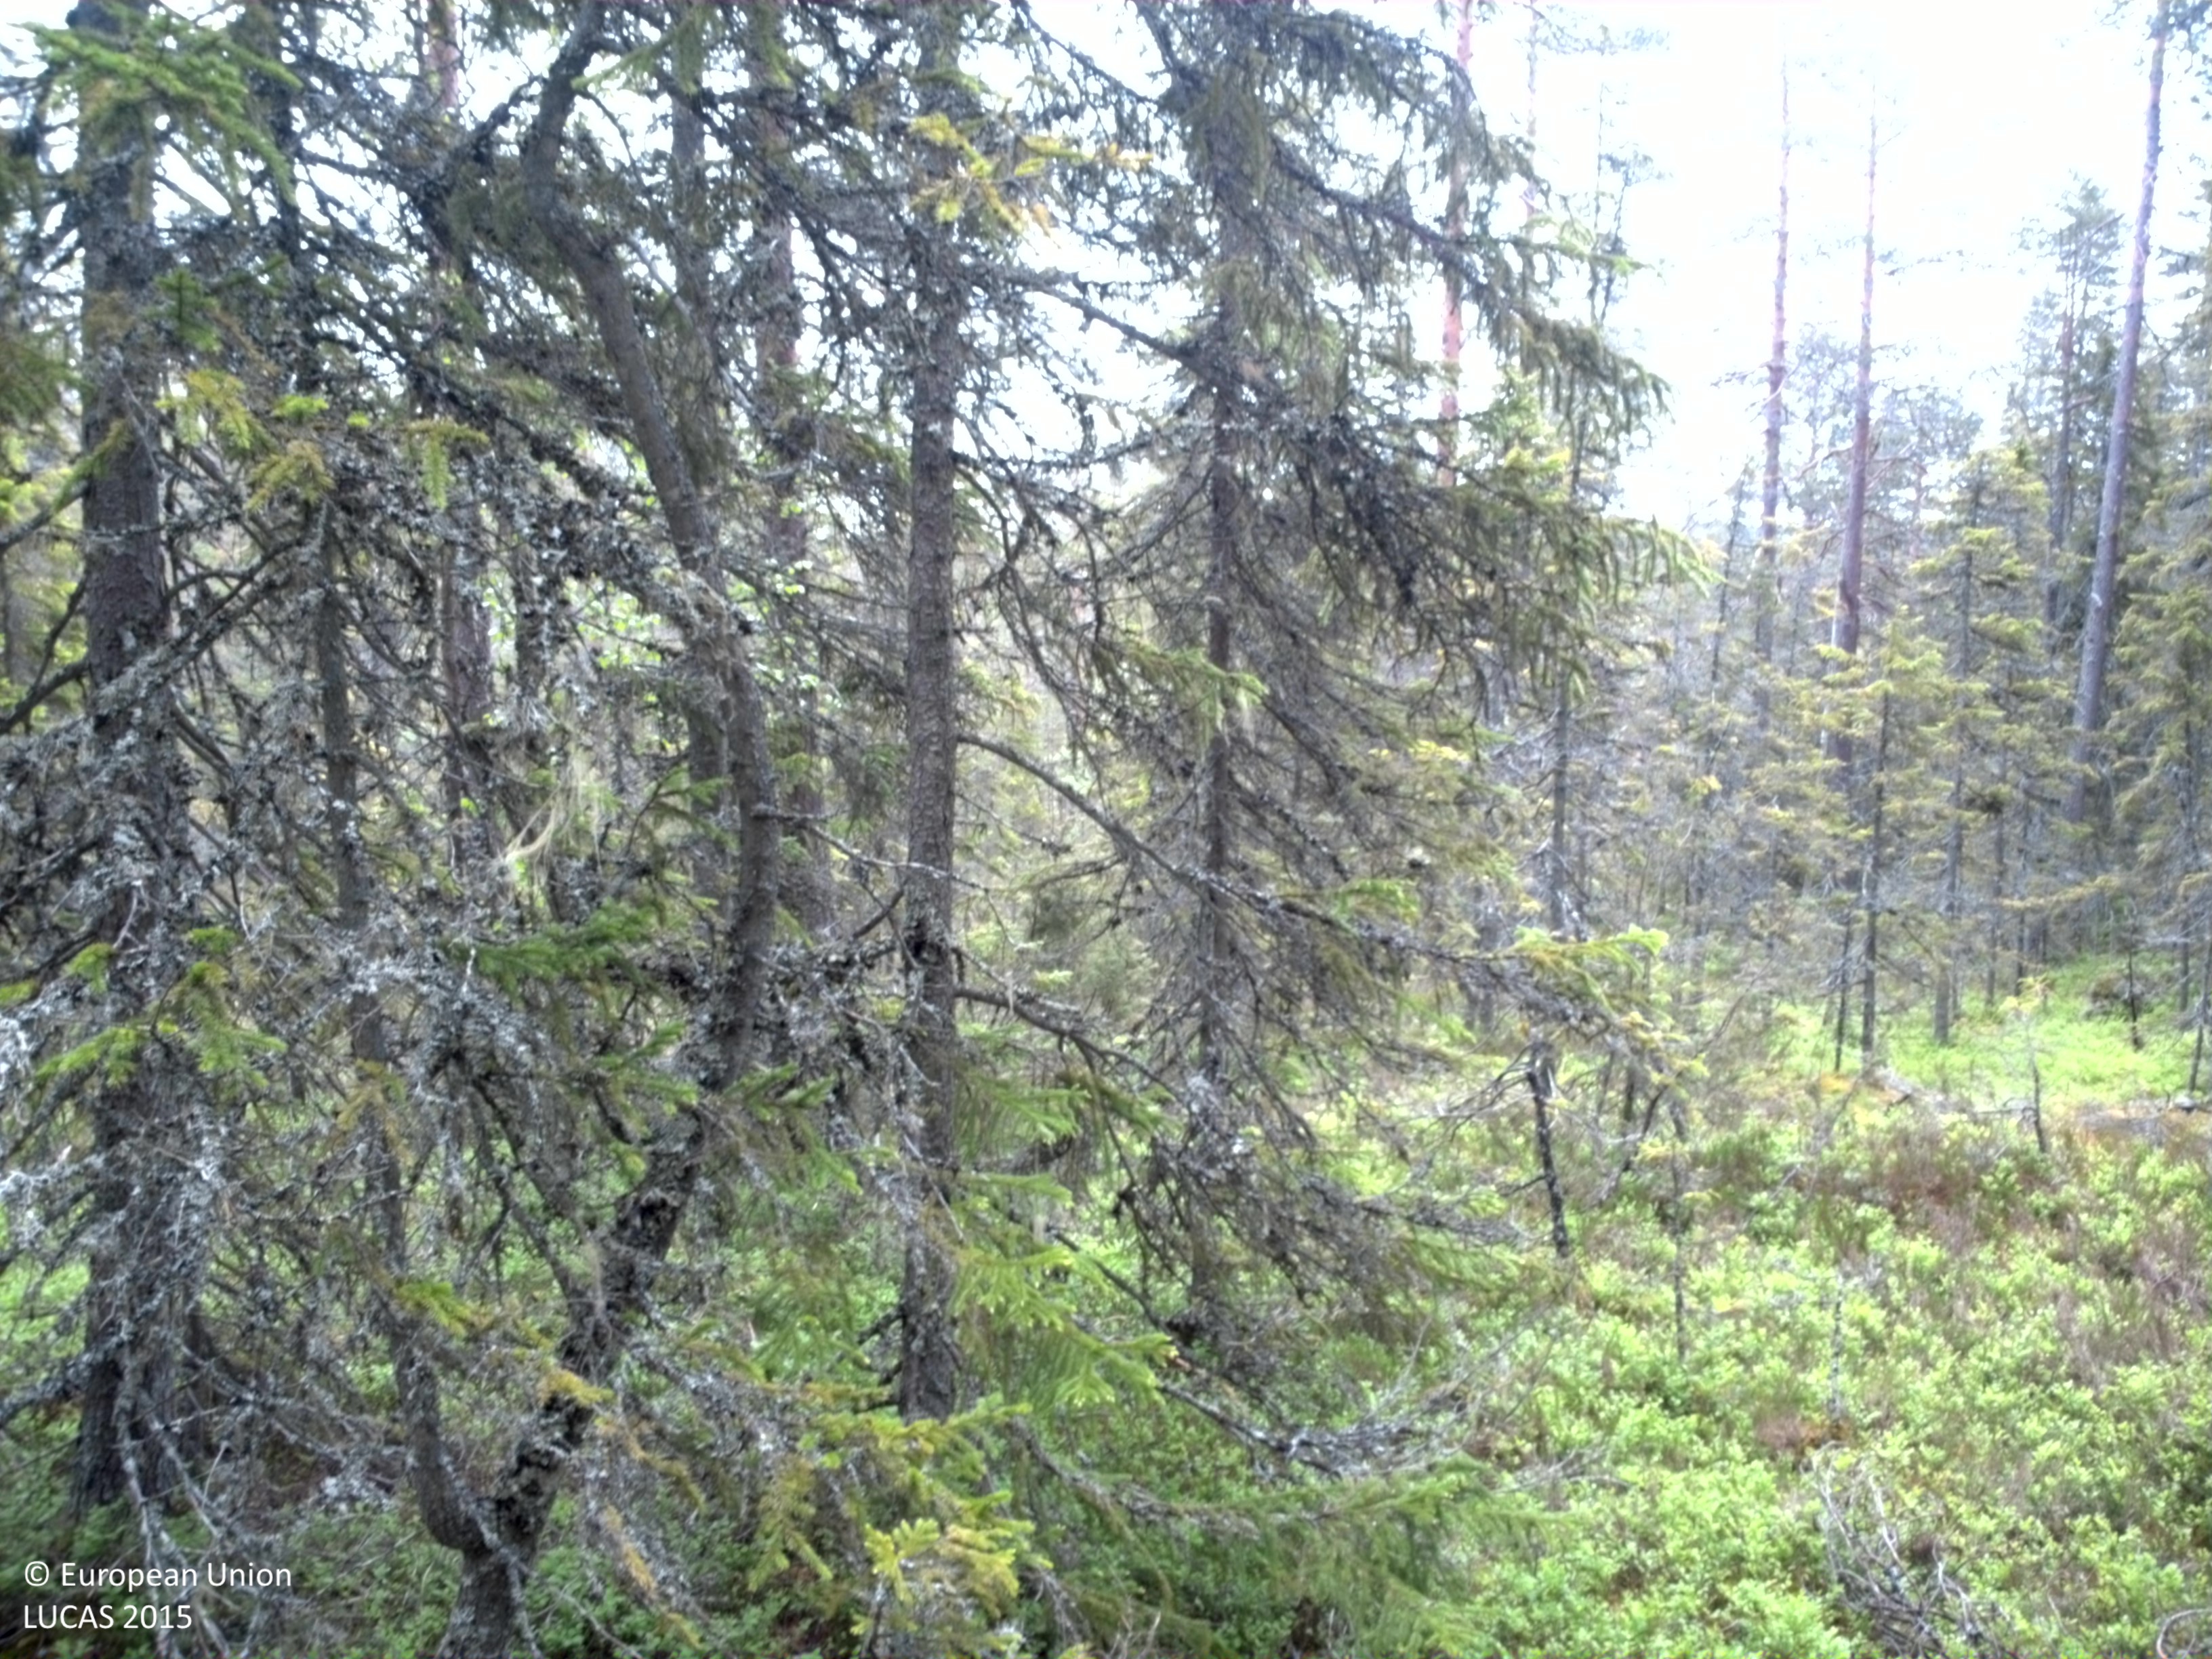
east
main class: Woodland
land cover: Other coniferous woodland
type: boreal forest
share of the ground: 50 - 75 %
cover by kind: coniferous forest trees 65 %, lichens and mosses 25 %, herbaceous plants 10 %
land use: Forestry
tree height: > 5 m
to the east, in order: Other coniferous woodland; Rivers and streams; Pine dominated coniferous woodland; Electric lines; Pine dominated coniferous woodland
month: July
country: SE
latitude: 61.4326
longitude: 13.6052
